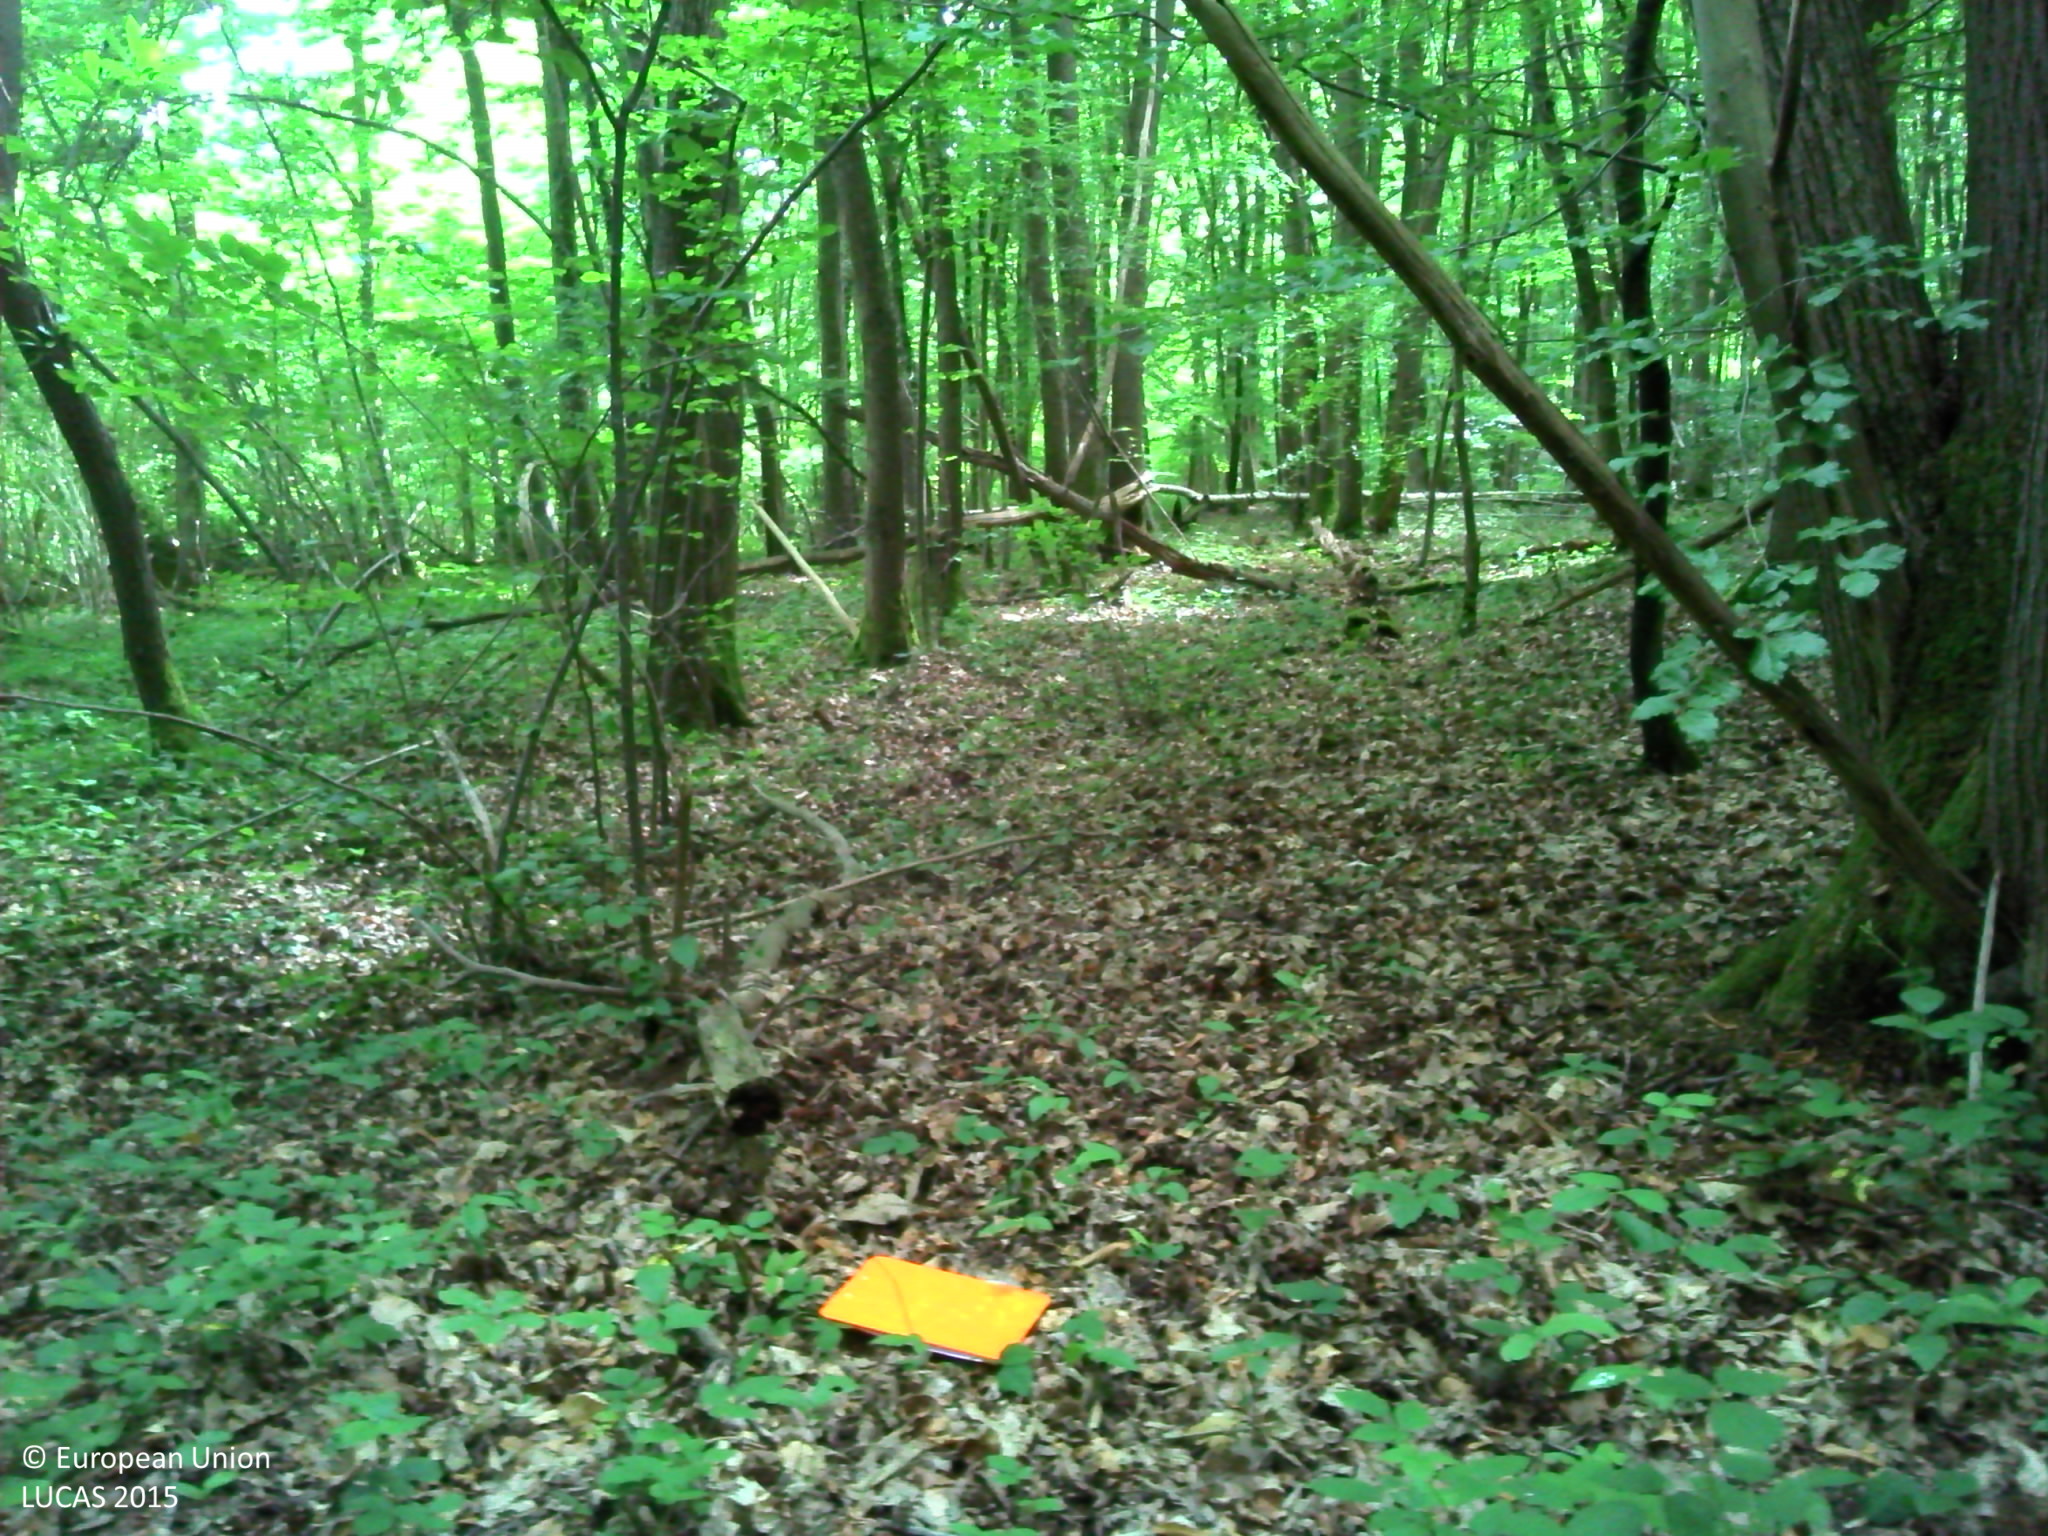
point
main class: Woodland
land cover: Broadleaved woodland
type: mesophytic deciduous forest
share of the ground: > 75 %
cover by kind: broadleaved forest trees 80 %, herbaceous plants 10 %, consolidated bare surface 10 %
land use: Forestry
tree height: > 5 m
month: June
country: FR
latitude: 49.2536
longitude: 1.0619
